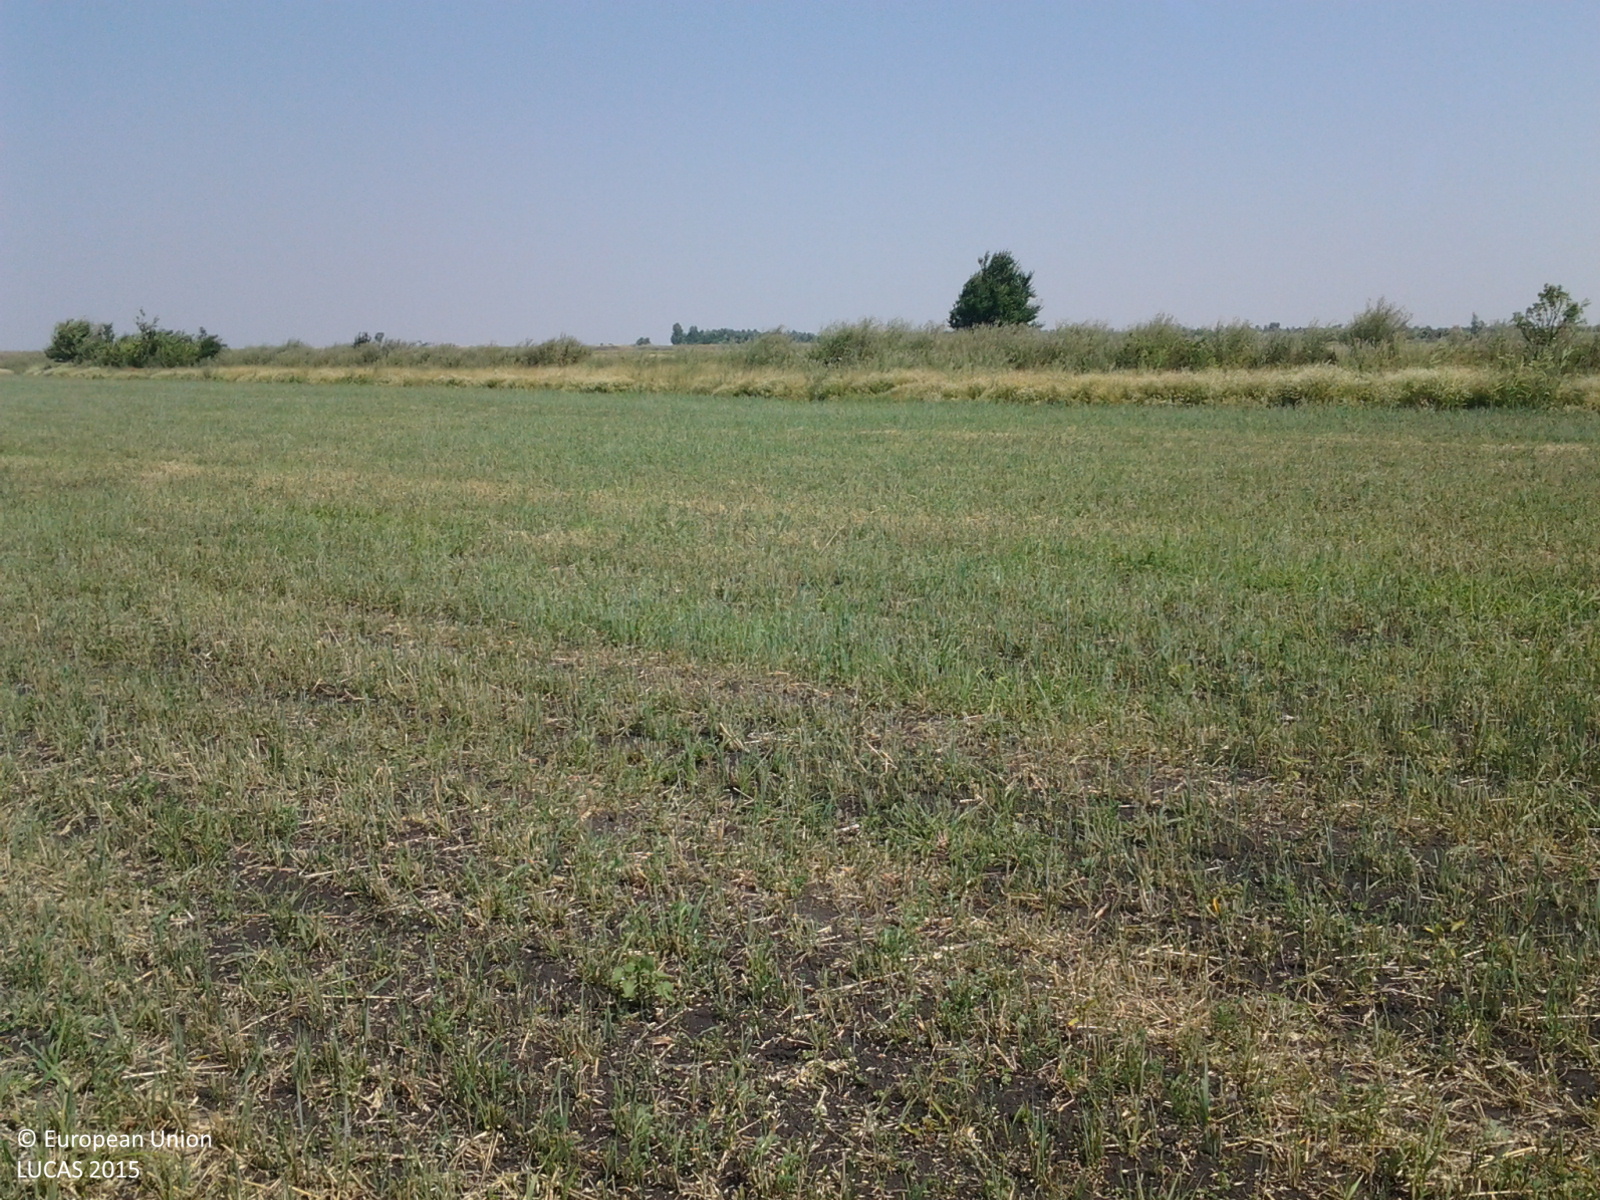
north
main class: Cropland
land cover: Oats
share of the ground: < 10 %
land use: Agriculture (excluding fallow land and kitchen gardens)
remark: Harvested field
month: July
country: HU
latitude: 47.4514
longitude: 20.2809
